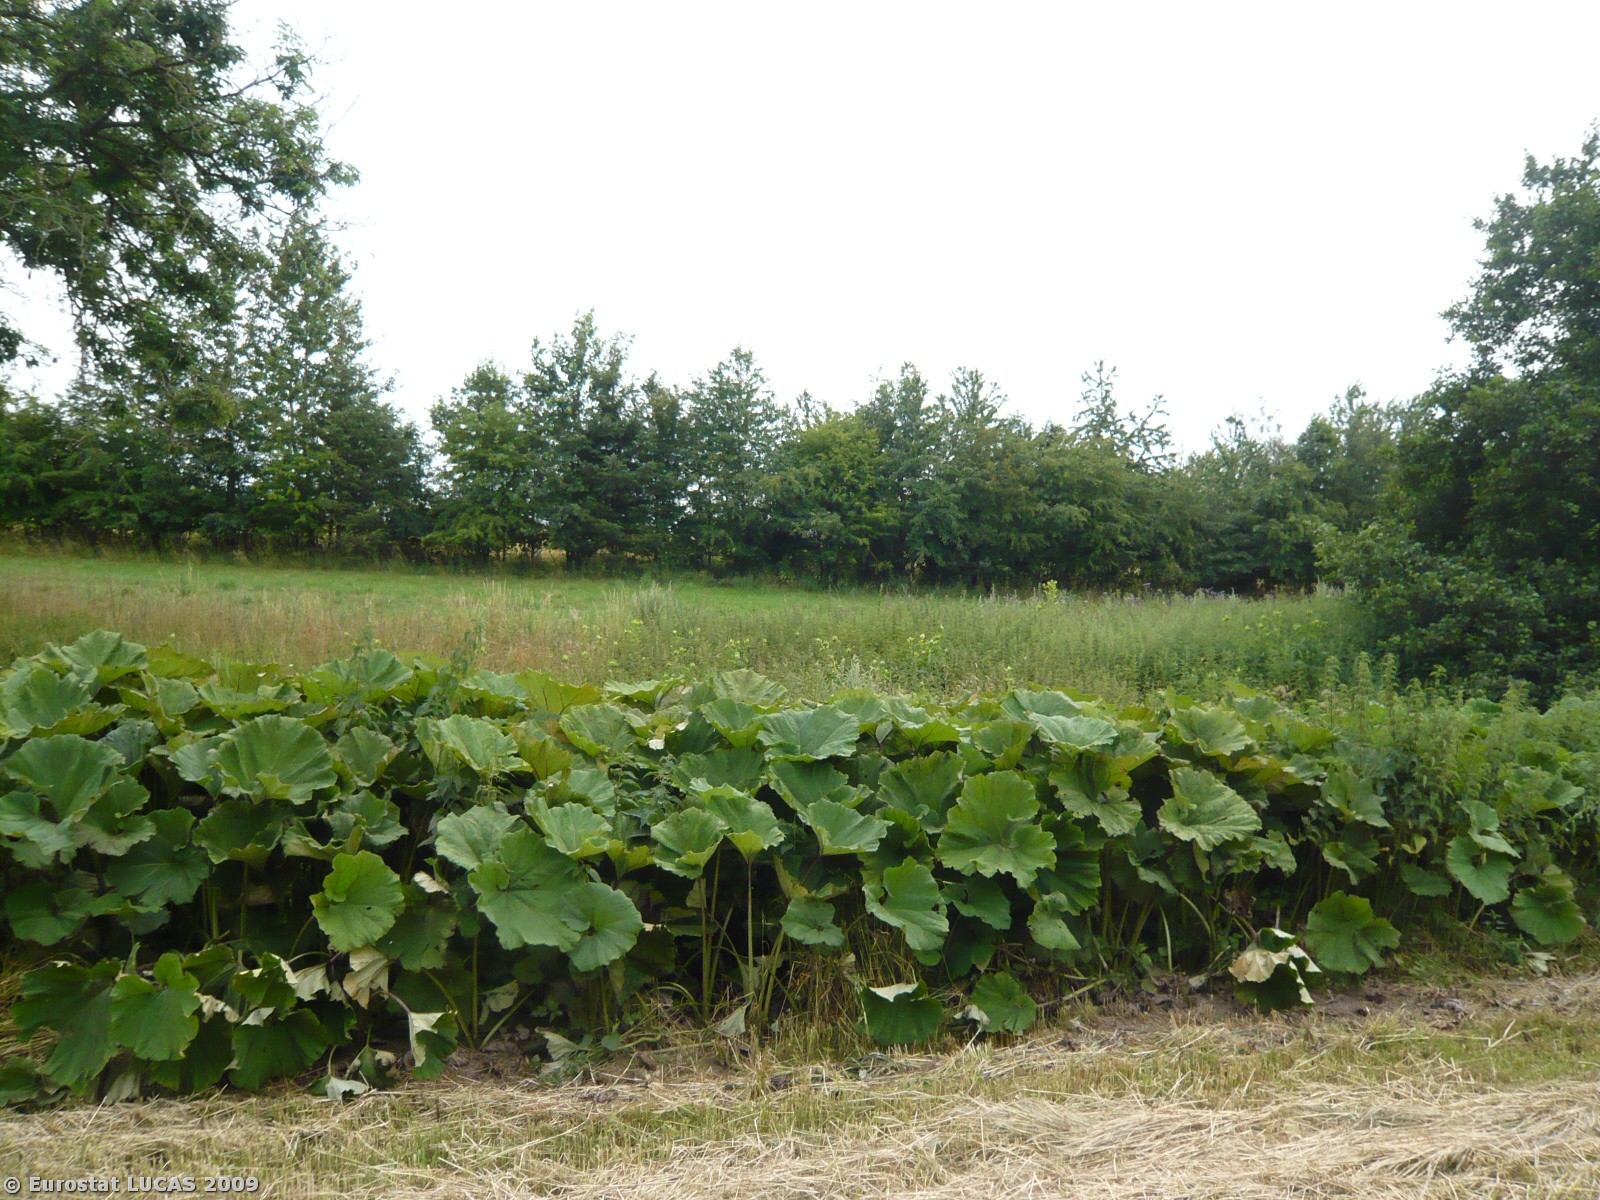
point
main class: Grassland
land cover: Grassland without tree/shrub cover
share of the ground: > 75 %
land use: Agriculture (excluding fallow land and kitchen gardens)
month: July
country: DK
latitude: 55.5285
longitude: 11.7570
